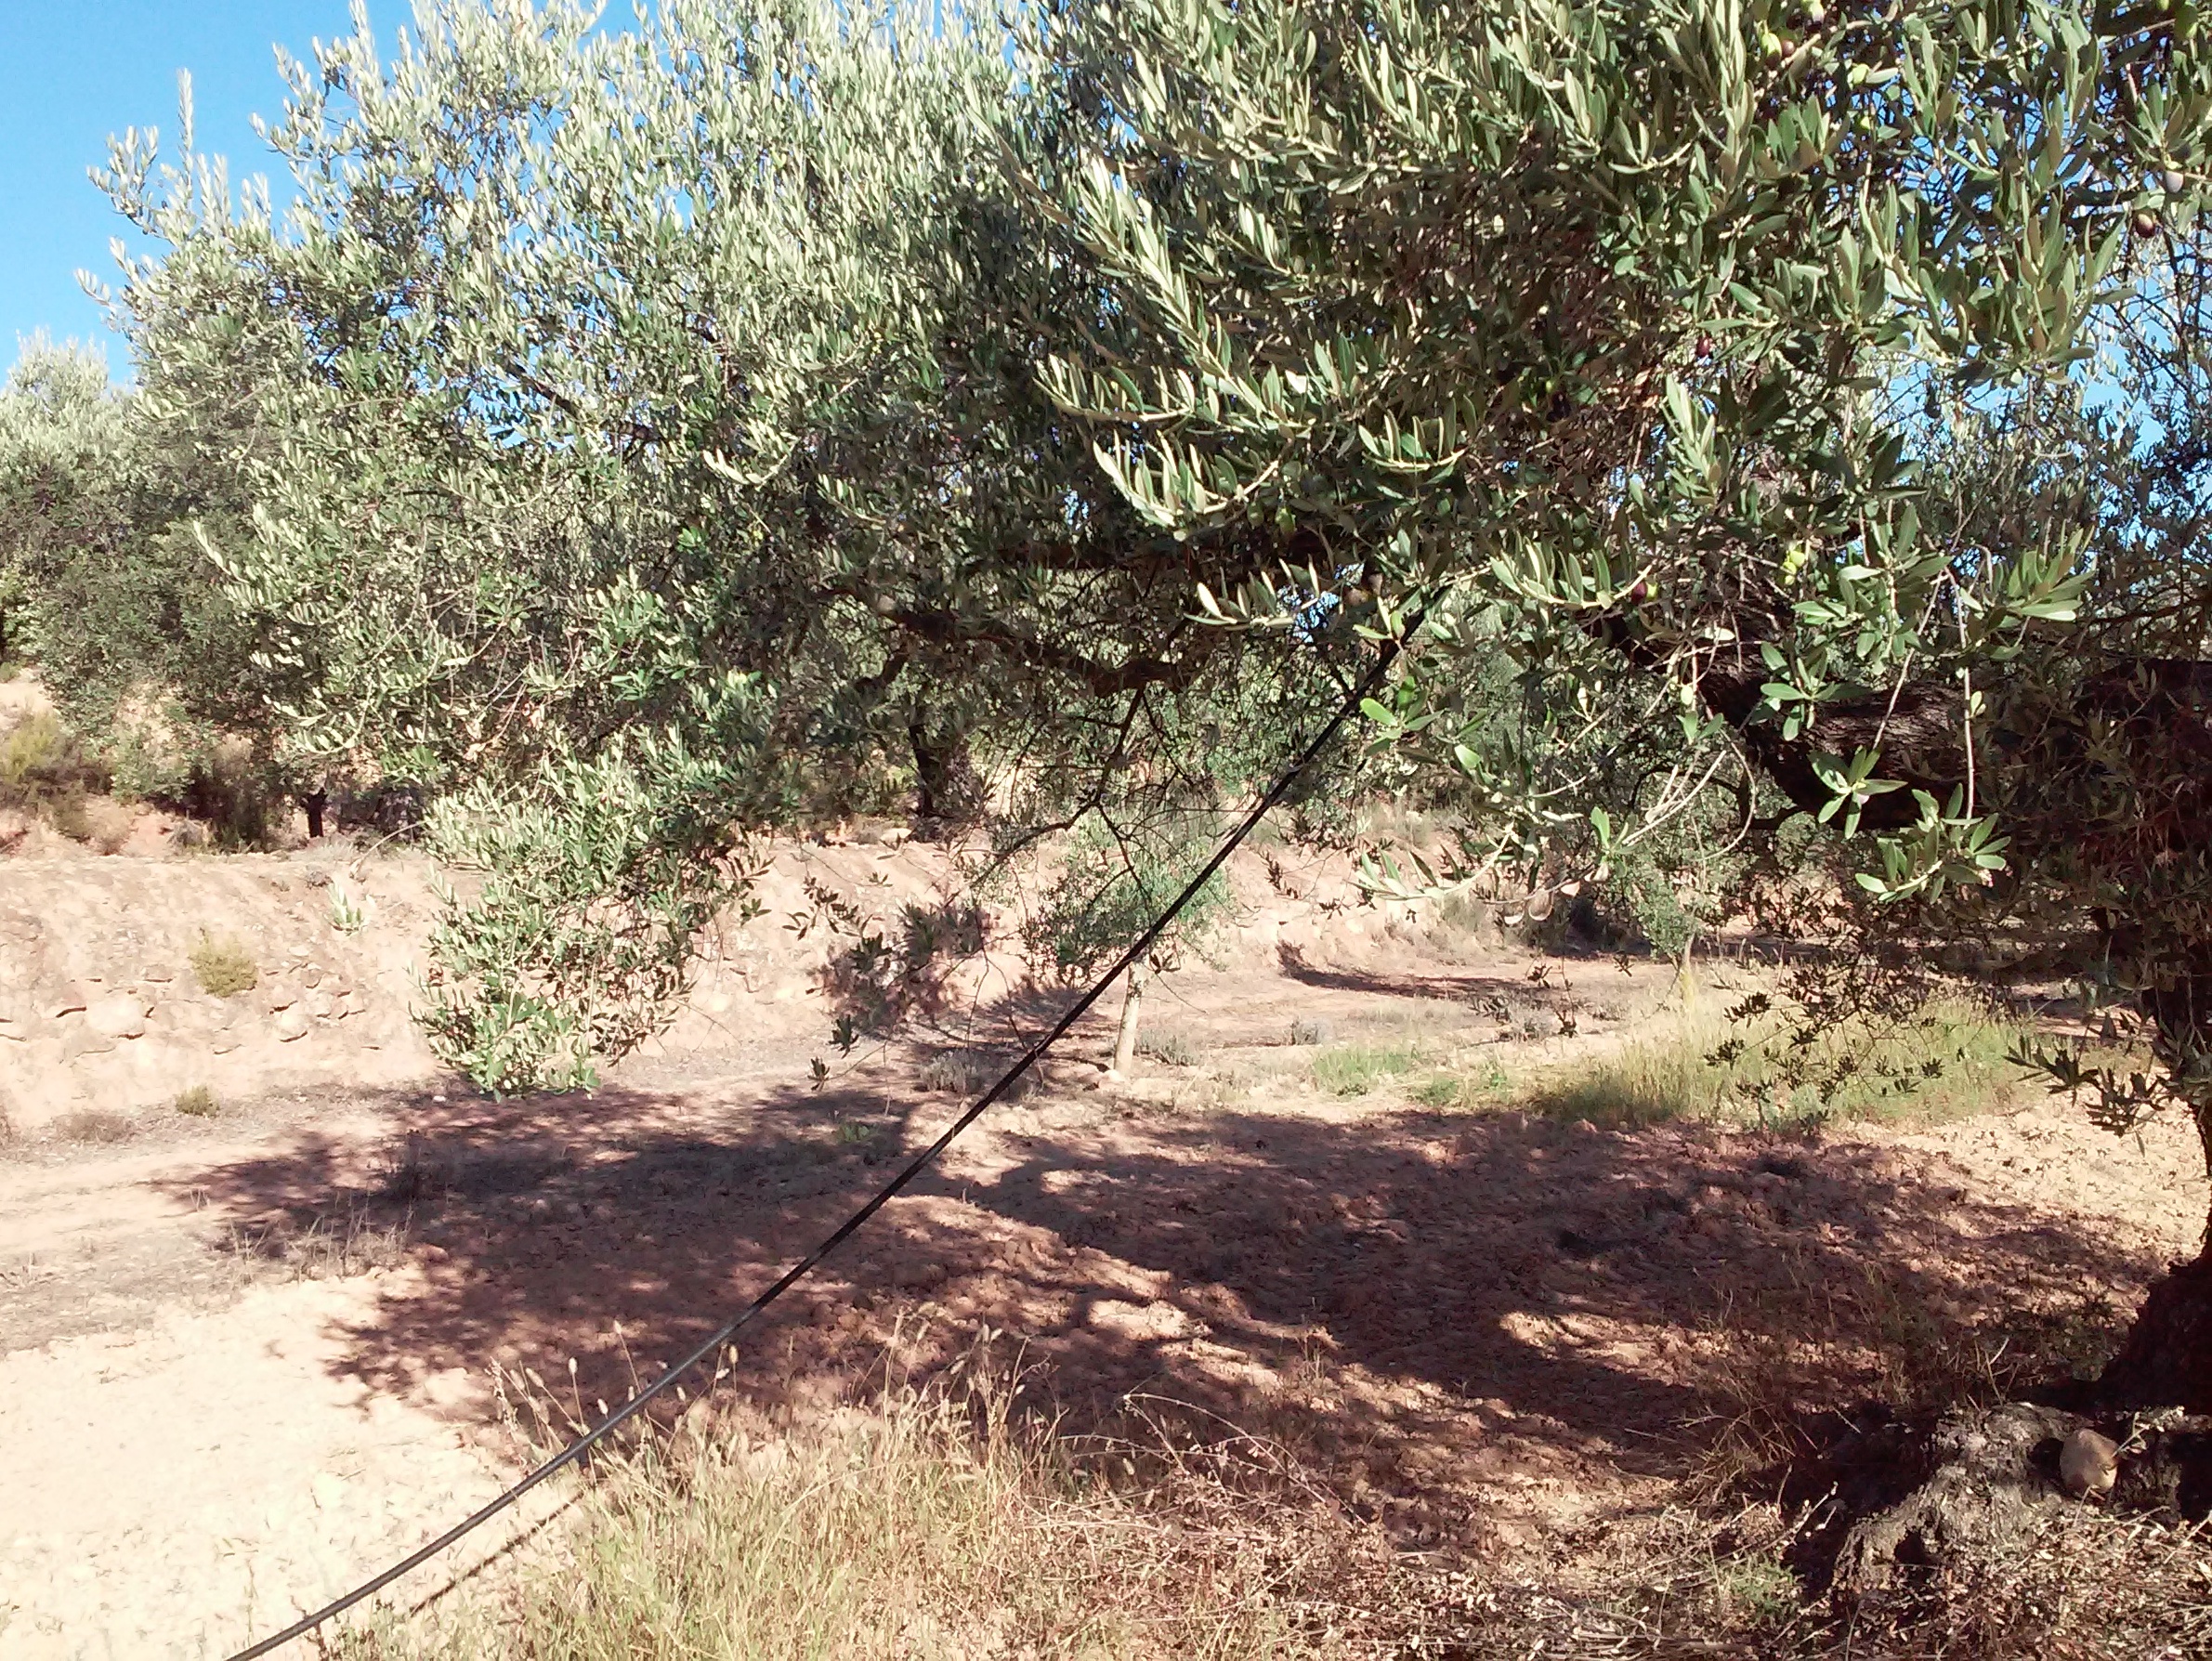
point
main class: Cropland
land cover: Olive groves
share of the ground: 25 - 50 %
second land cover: Other bare soil
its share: > 75 %
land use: Agriculture (excluding fallow land and kitchen gardens)
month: September
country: ES
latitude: 41.1919
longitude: 0.5357
